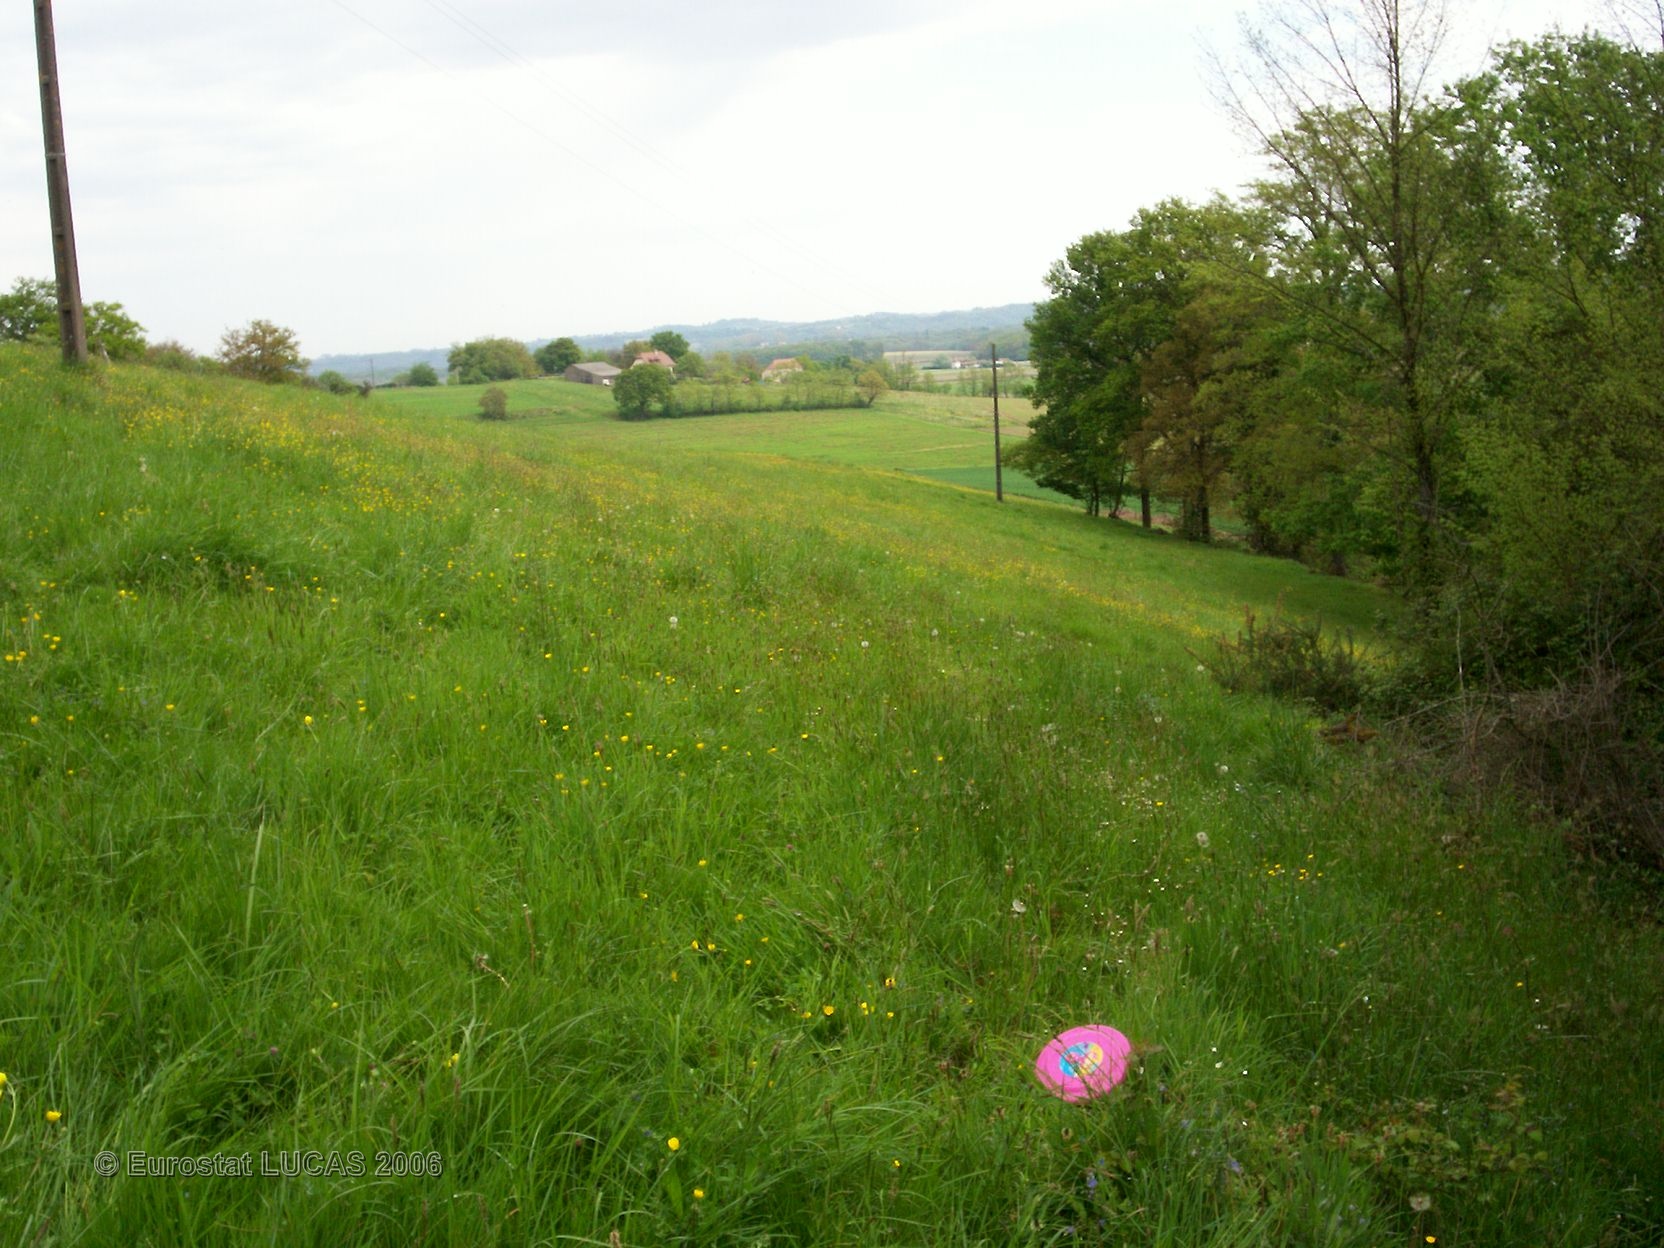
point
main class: Grassland
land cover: Grassland without tree/shrub cover
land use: Agriculture (excluding fallow land and kitchen gardens)
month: April
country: FR
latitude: 43.4911
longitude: -0.6573
